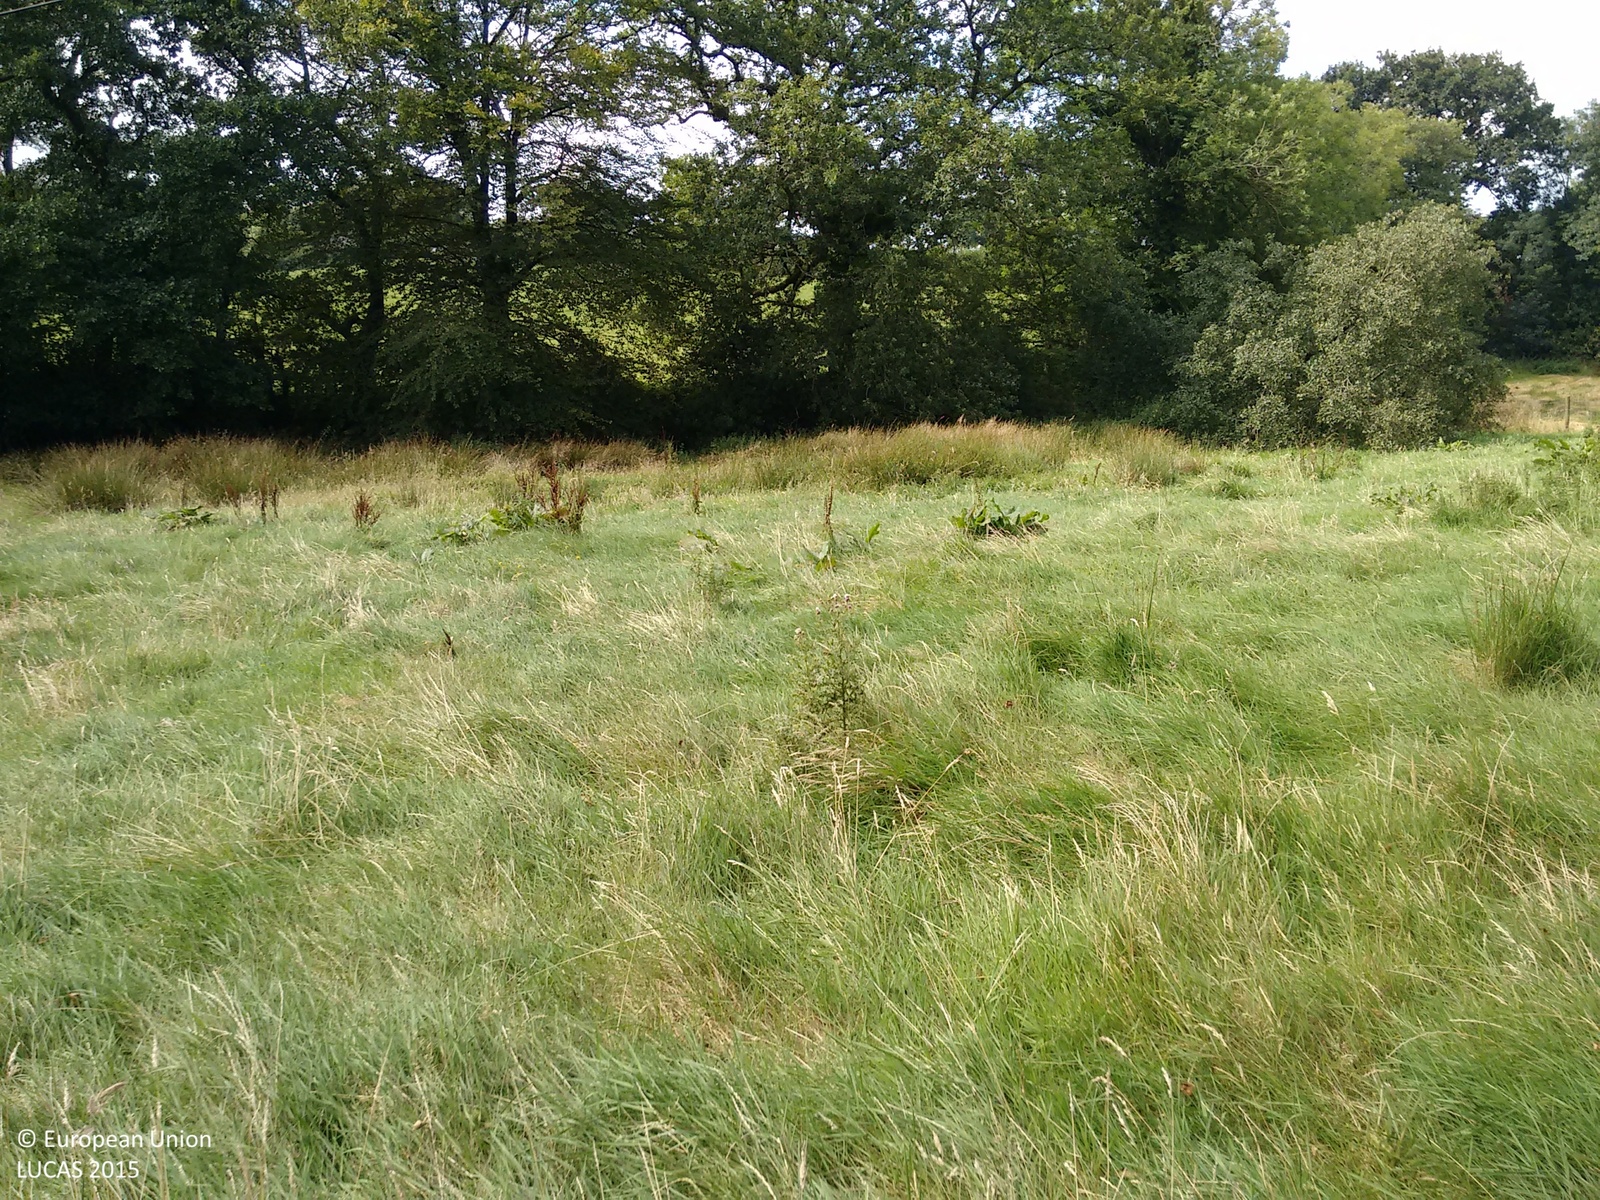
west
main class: Grassland
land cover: Grassland without tree/shrub cover
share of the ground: > 75 %
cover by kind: herbaceous plants 100 %
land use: Agriculture (excluding fallow land and kitchen gardens)
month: September
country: GB
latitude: 50.9406
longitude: -4.2891
